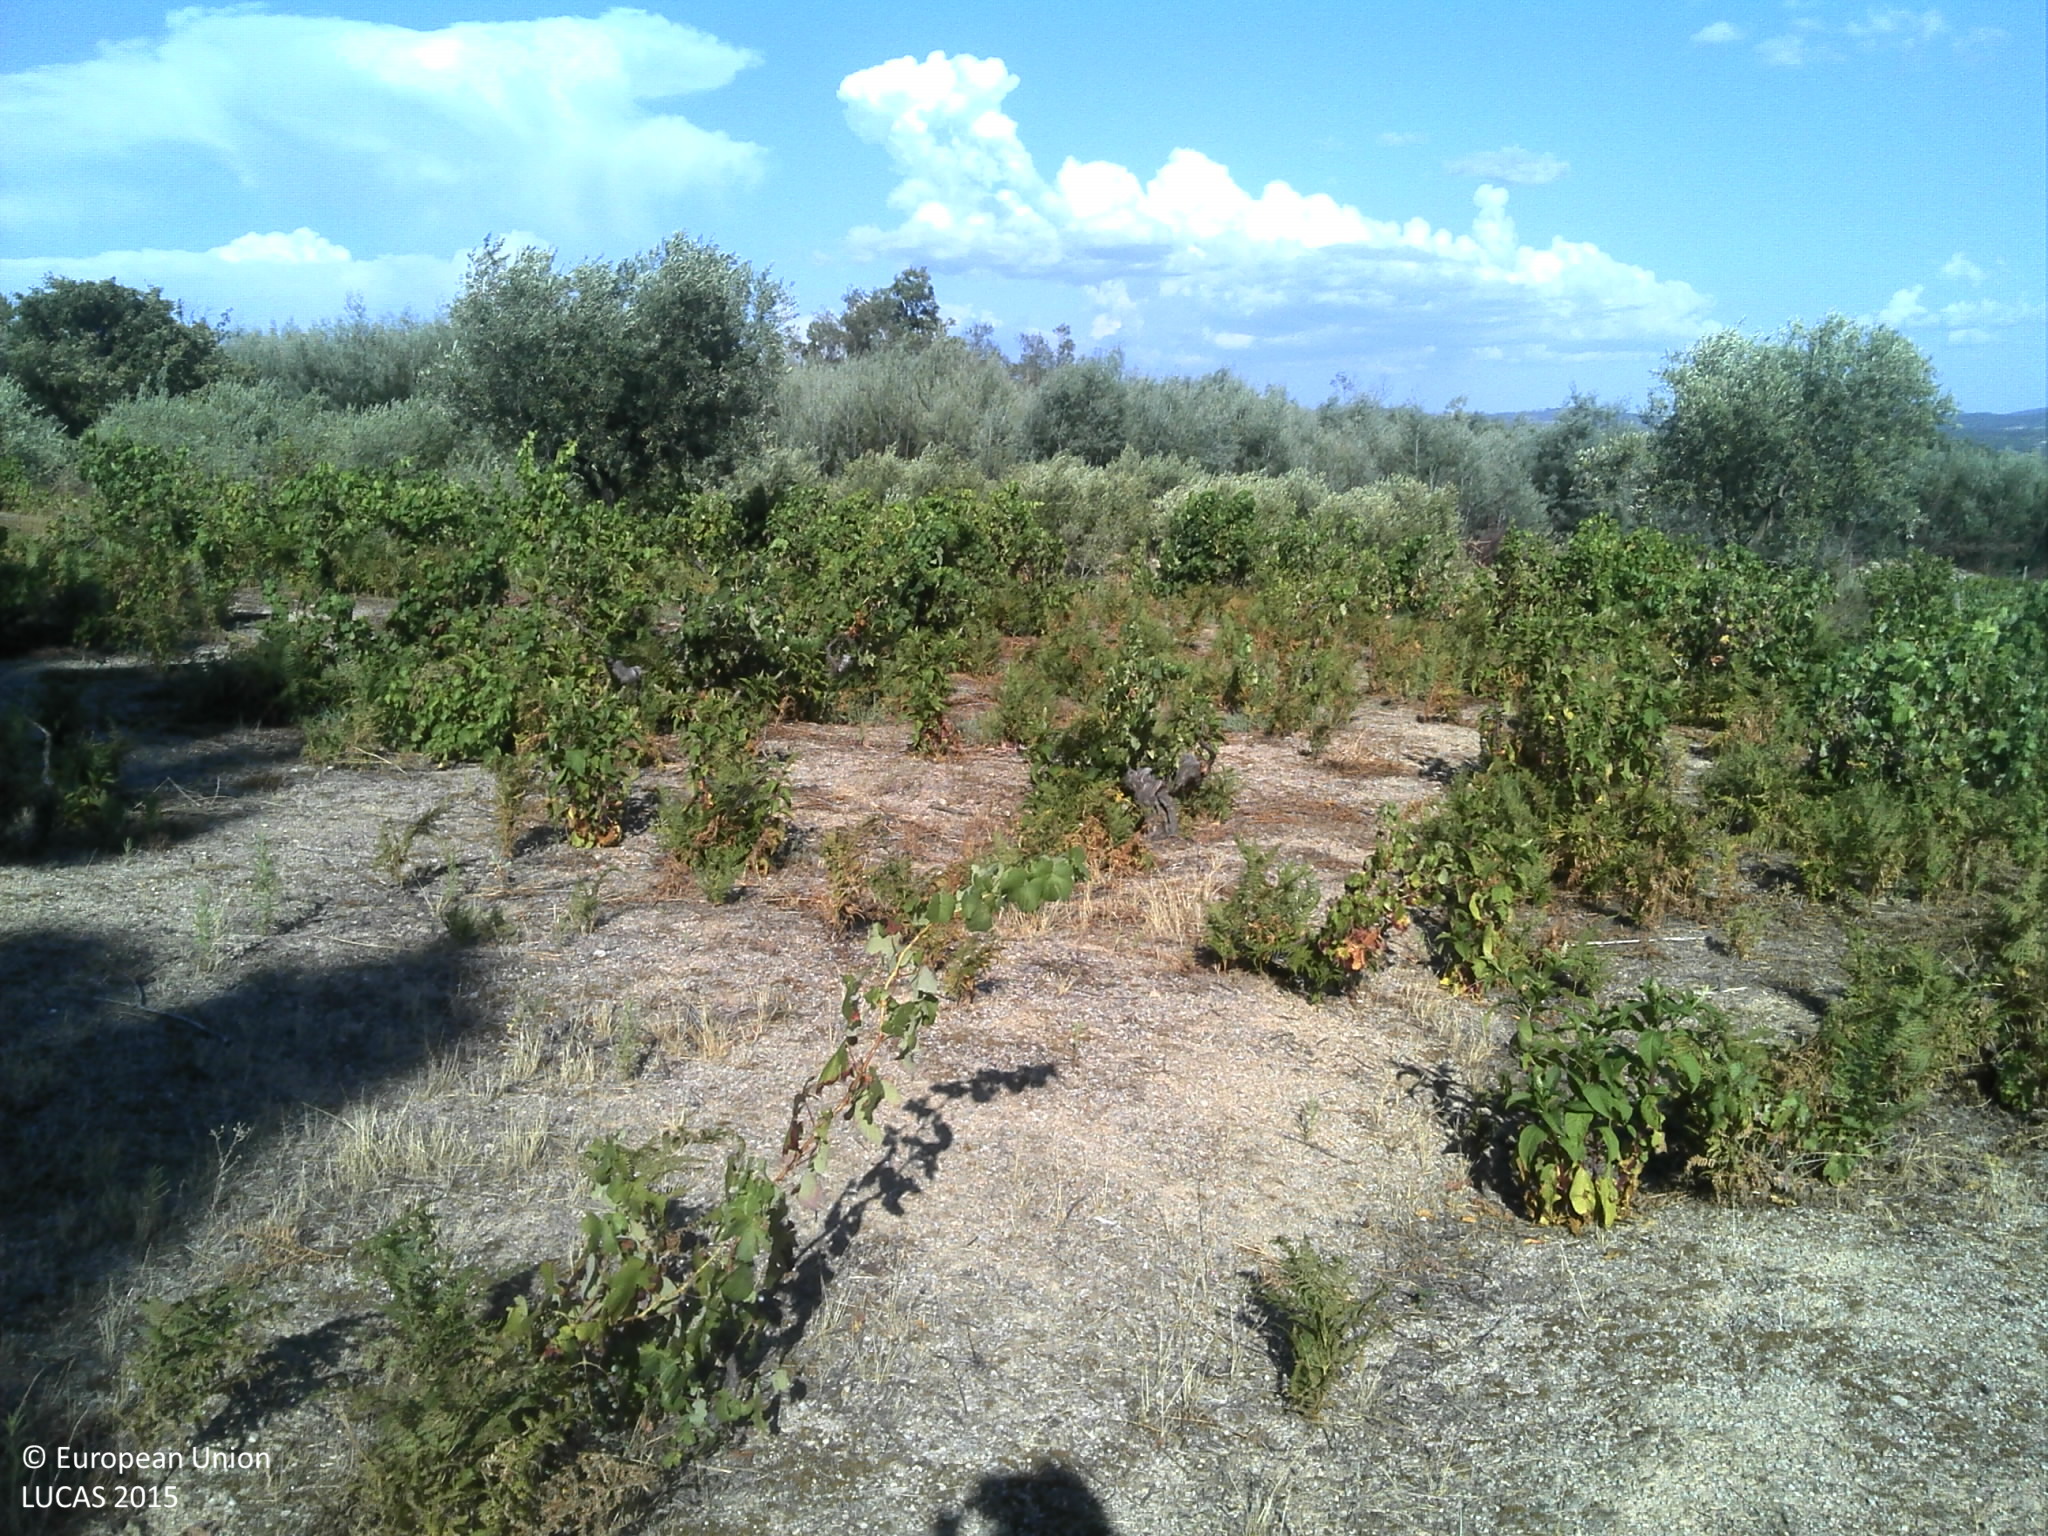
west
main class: Cropland
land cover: Vineyards
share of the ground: 10 - 25 %
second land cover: Spontaneously vegetated surfaces
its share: 10 - 25 %
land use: Agriculture (excluding fallow land and kitchen gardens)
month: July
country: PT
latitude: 40.2981
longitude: -7.4351
